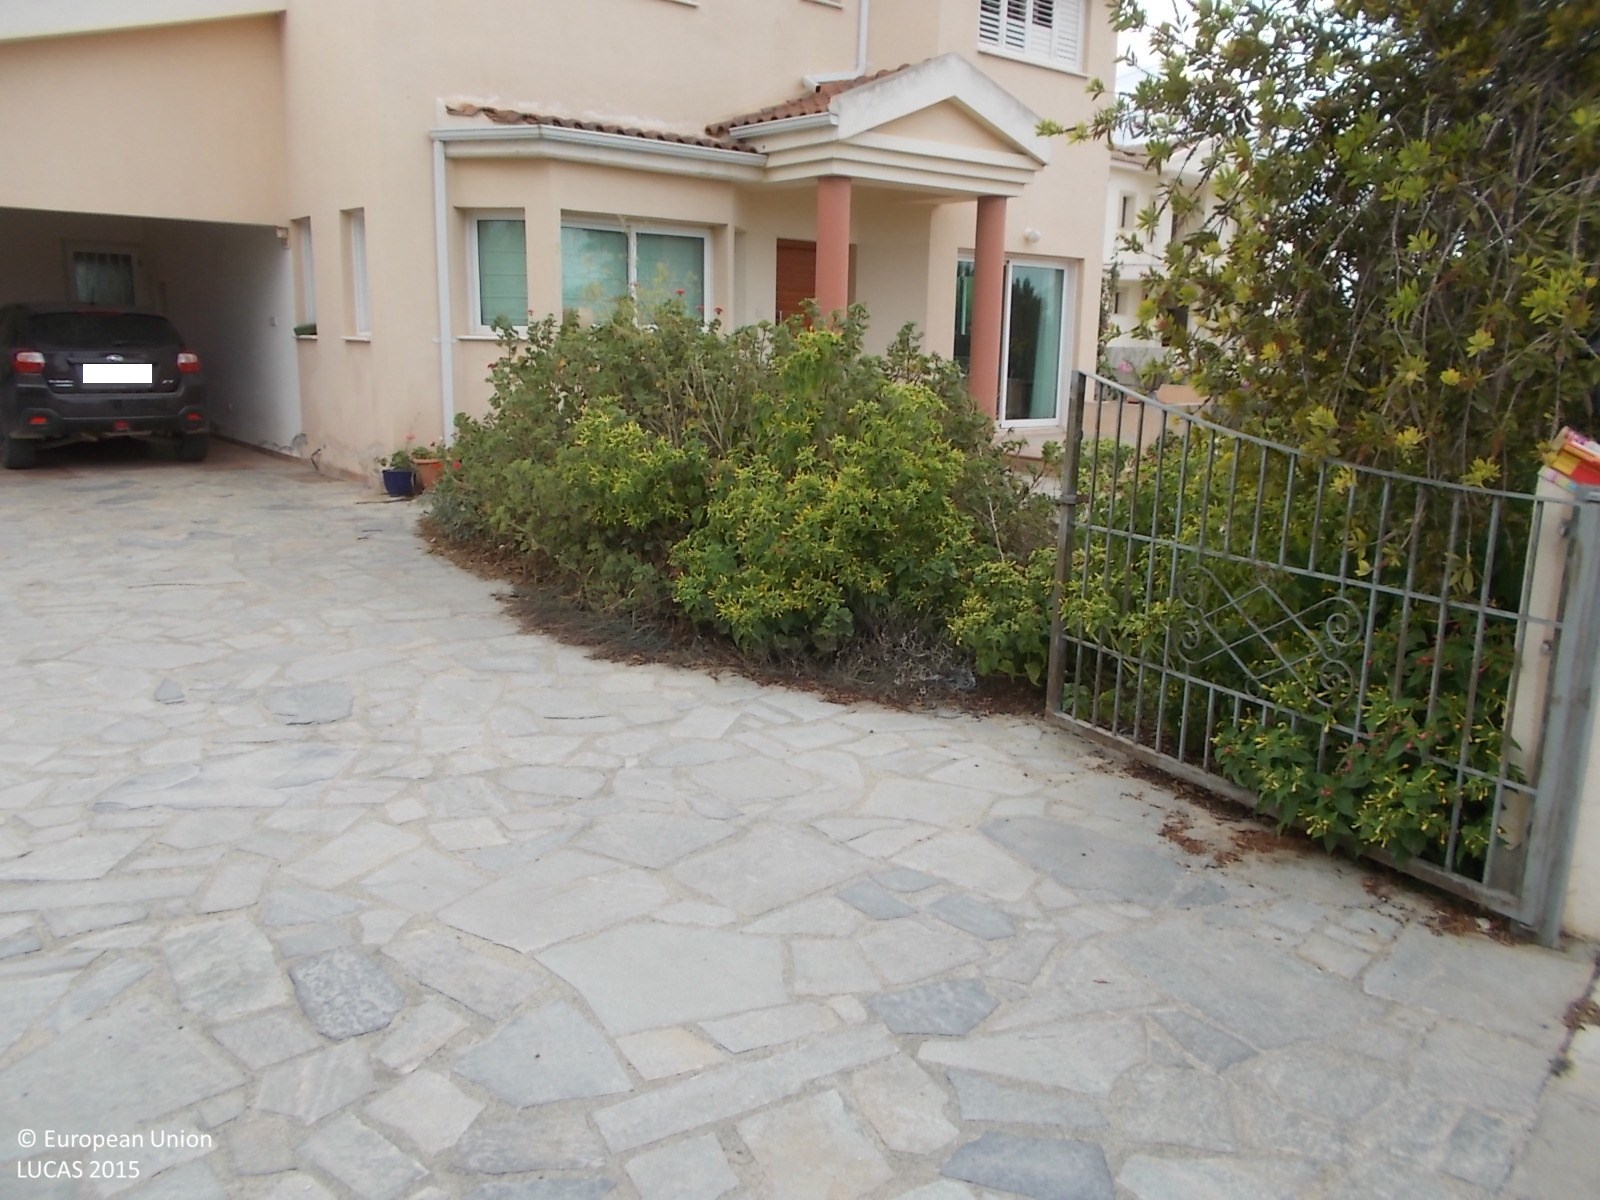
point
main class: Artificial land
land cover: Non built-up linear features
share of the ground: > 75 %
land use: Road transport
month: May
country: CY
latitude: 35.1536
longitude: 33.2066
